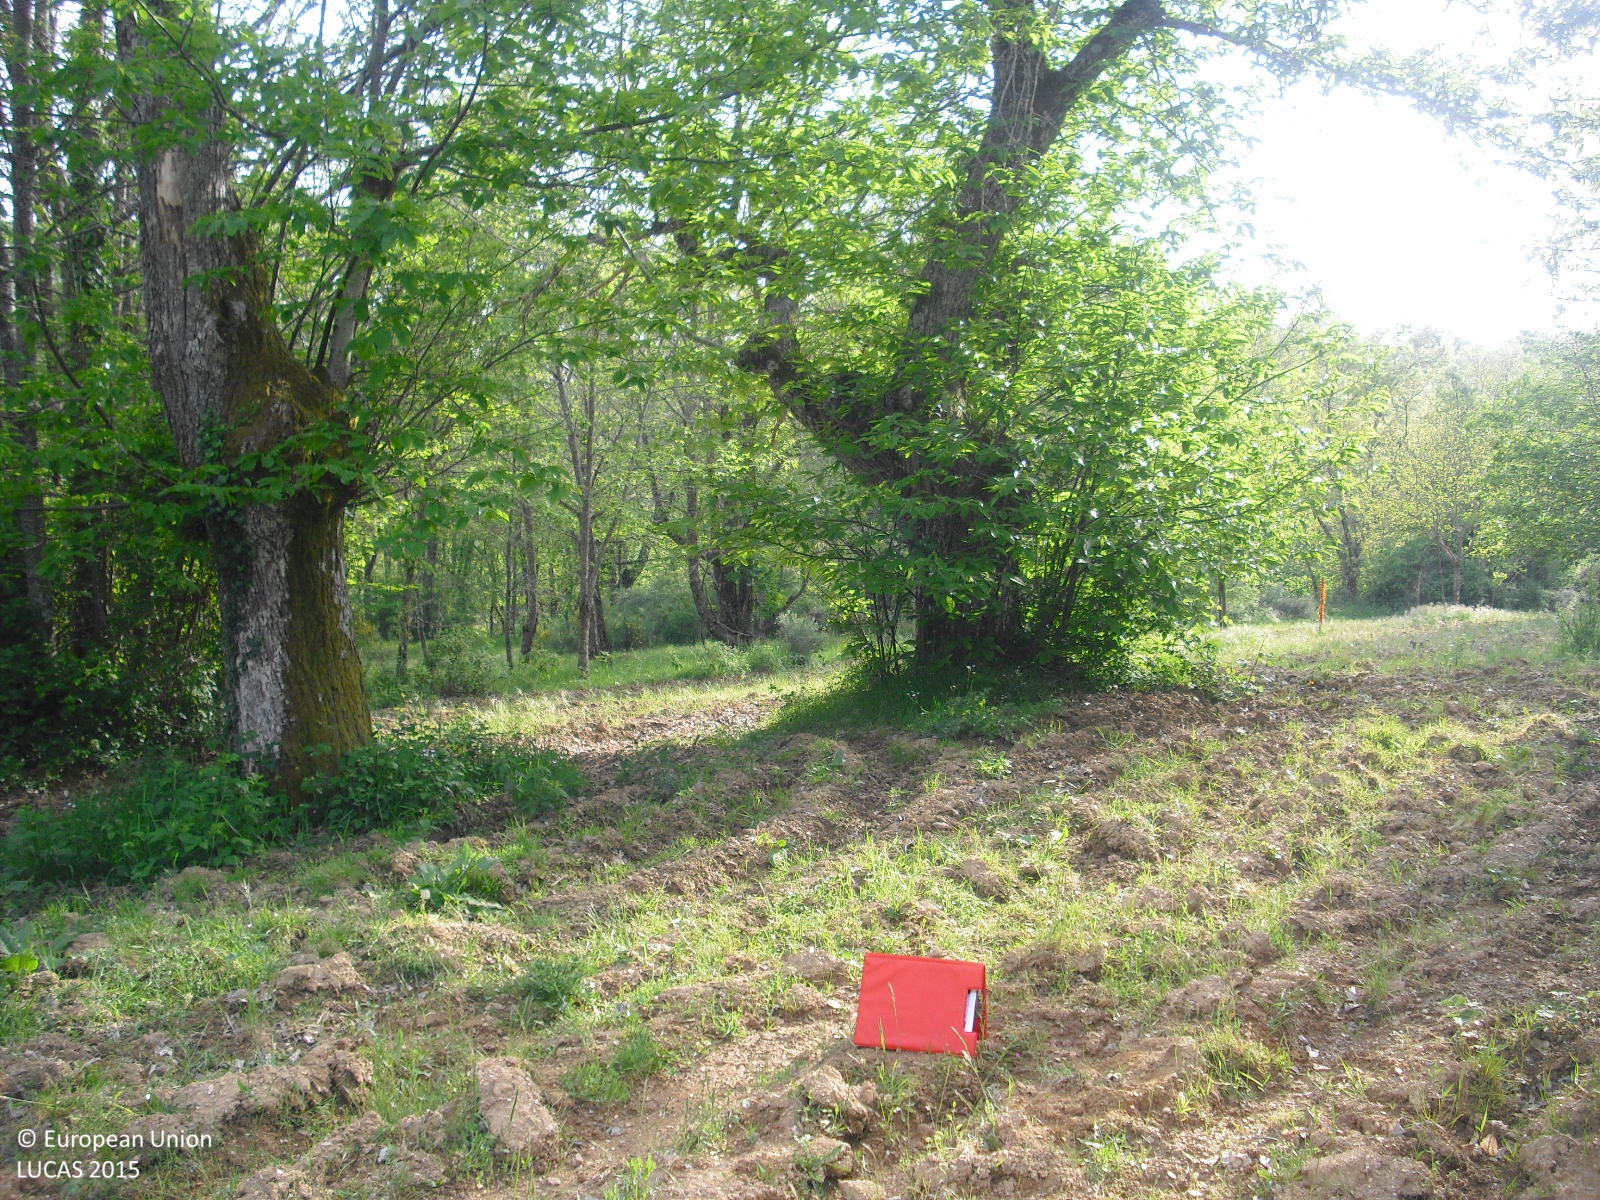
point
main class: Cropland
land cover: Nuts trees
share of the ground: 50 - 75 %
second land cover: Grassland without tree/shrub cover
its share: 50 - 75 %
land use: Agriculture (excluding fallow land and kitchen gardens)
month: May
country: ES
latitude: 41.9672
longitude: -7.2751
